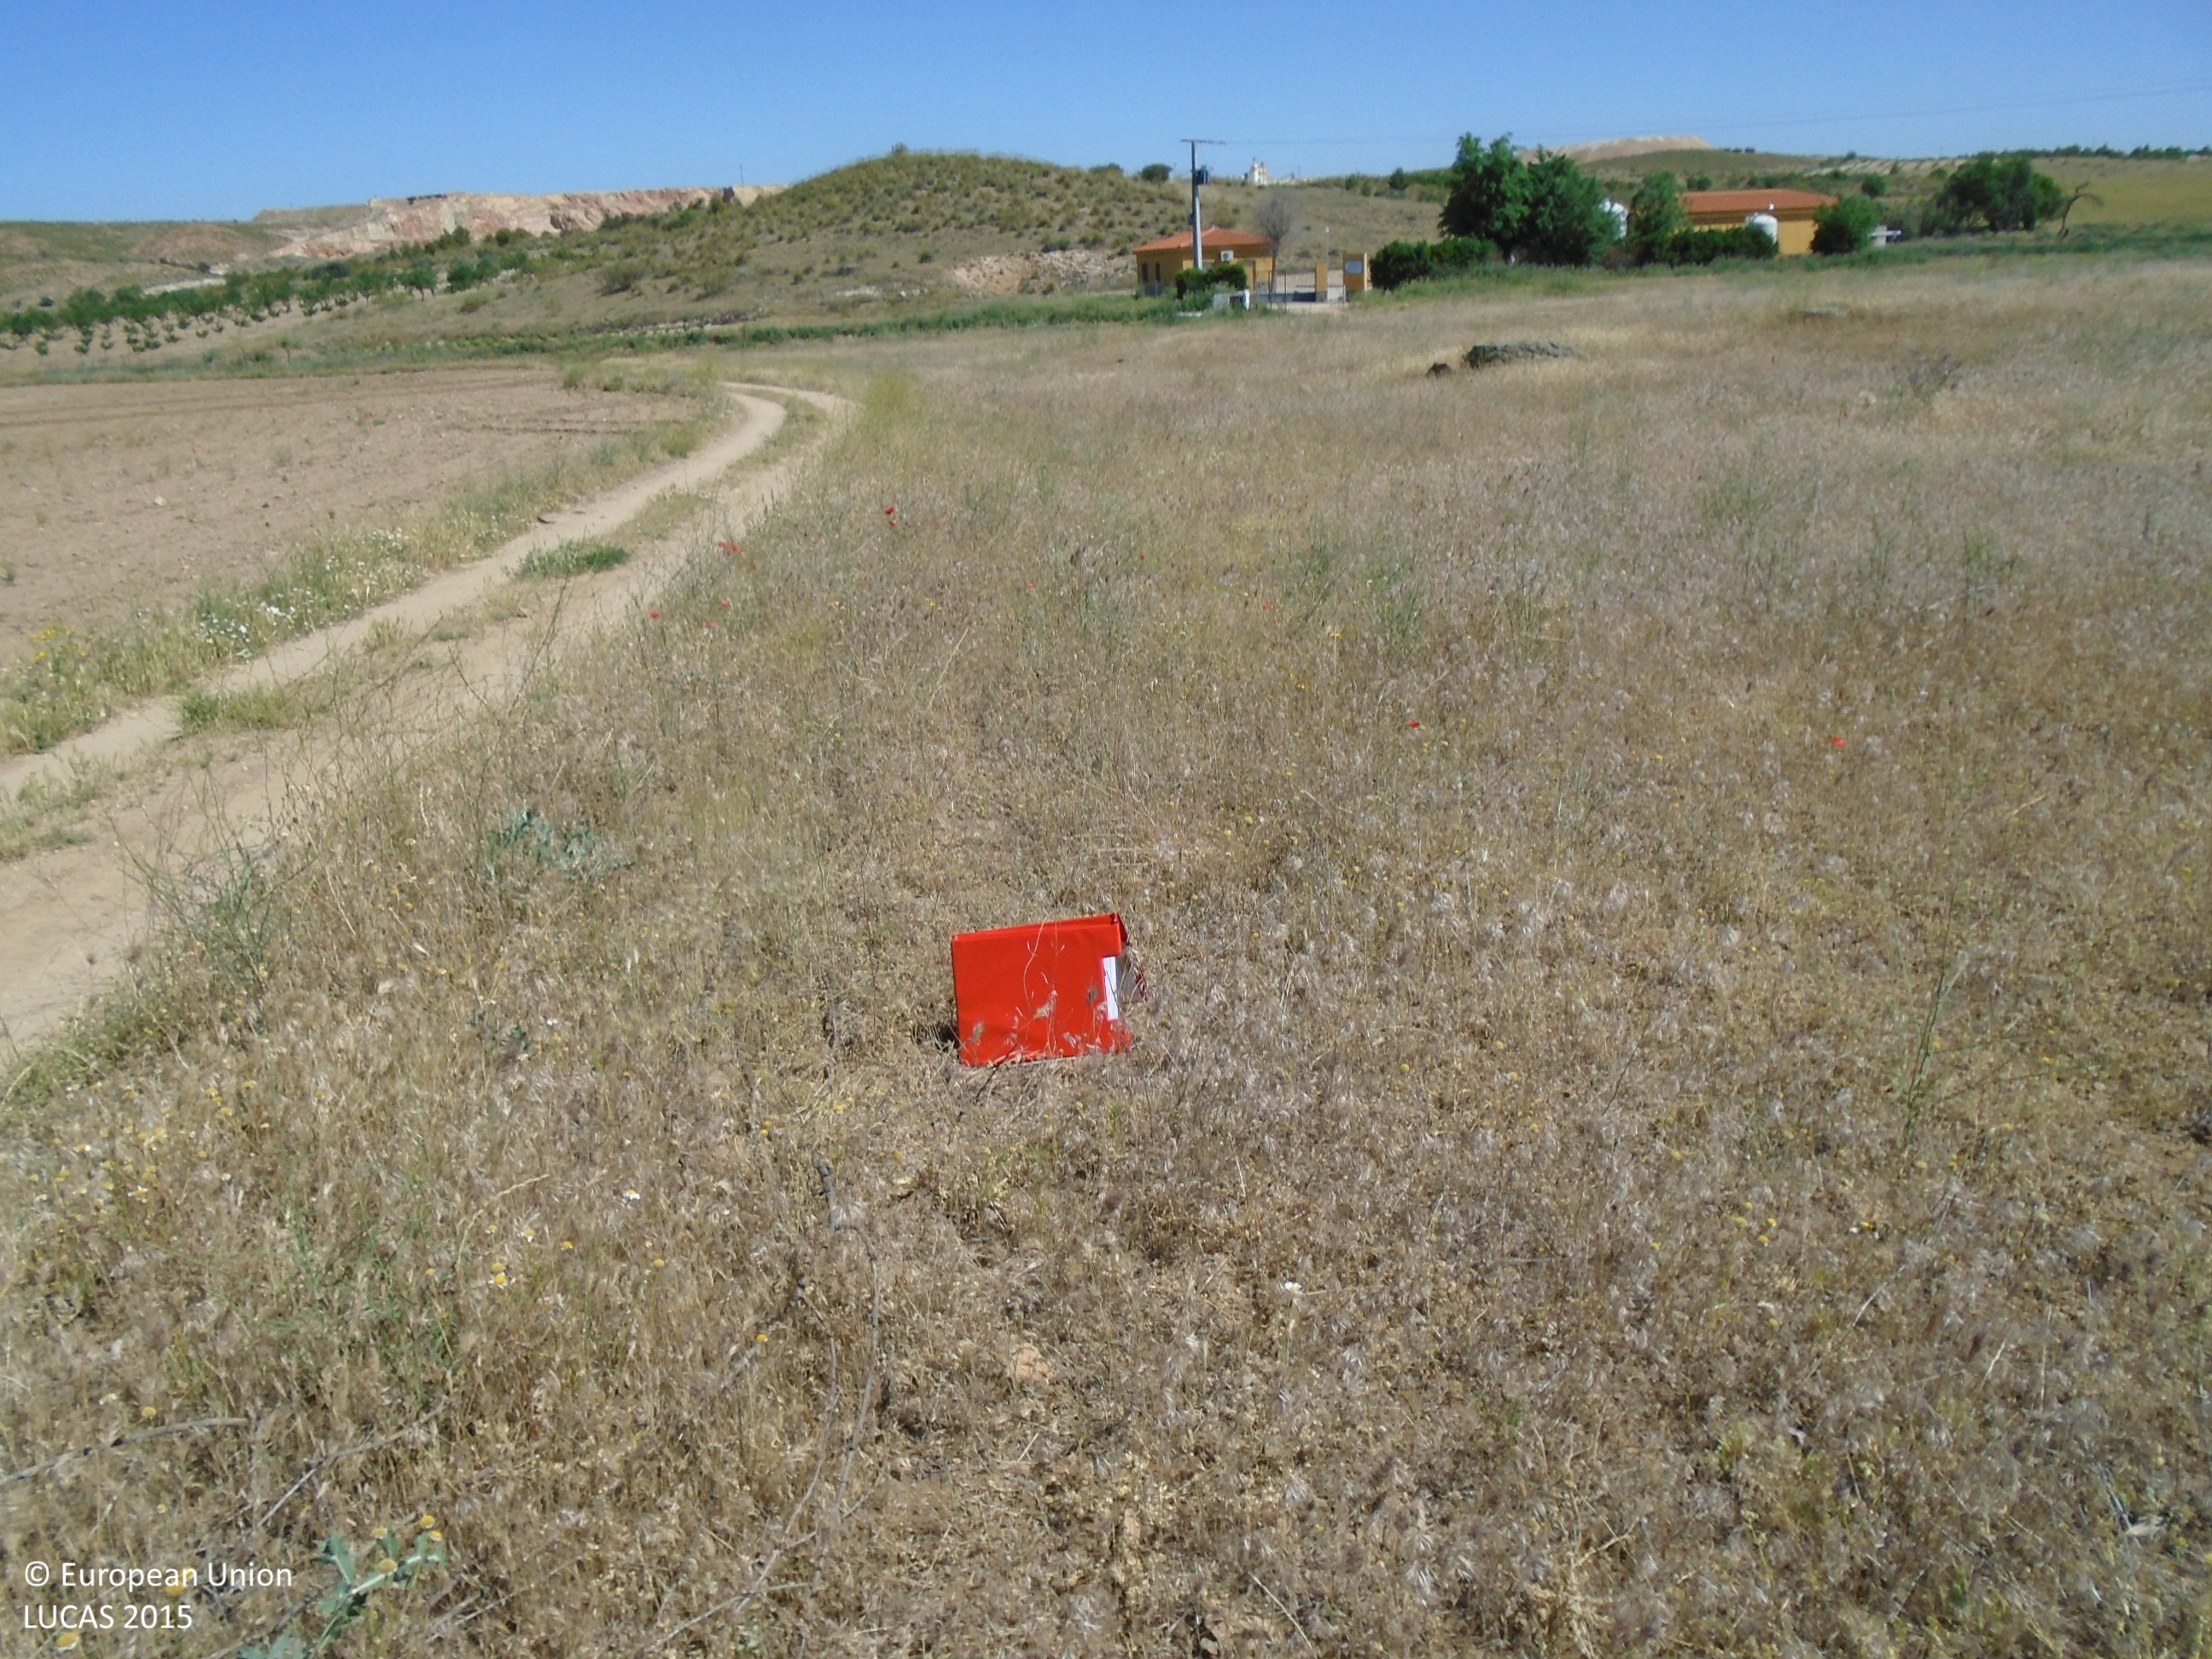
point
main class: Grassland
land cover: Spontaneously vegetated surfaces
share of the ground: > 75 %
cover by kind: herbaceous plants 100 %
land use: Fallow land
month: May
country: ES
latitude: 39.7274
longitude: -3.6666
